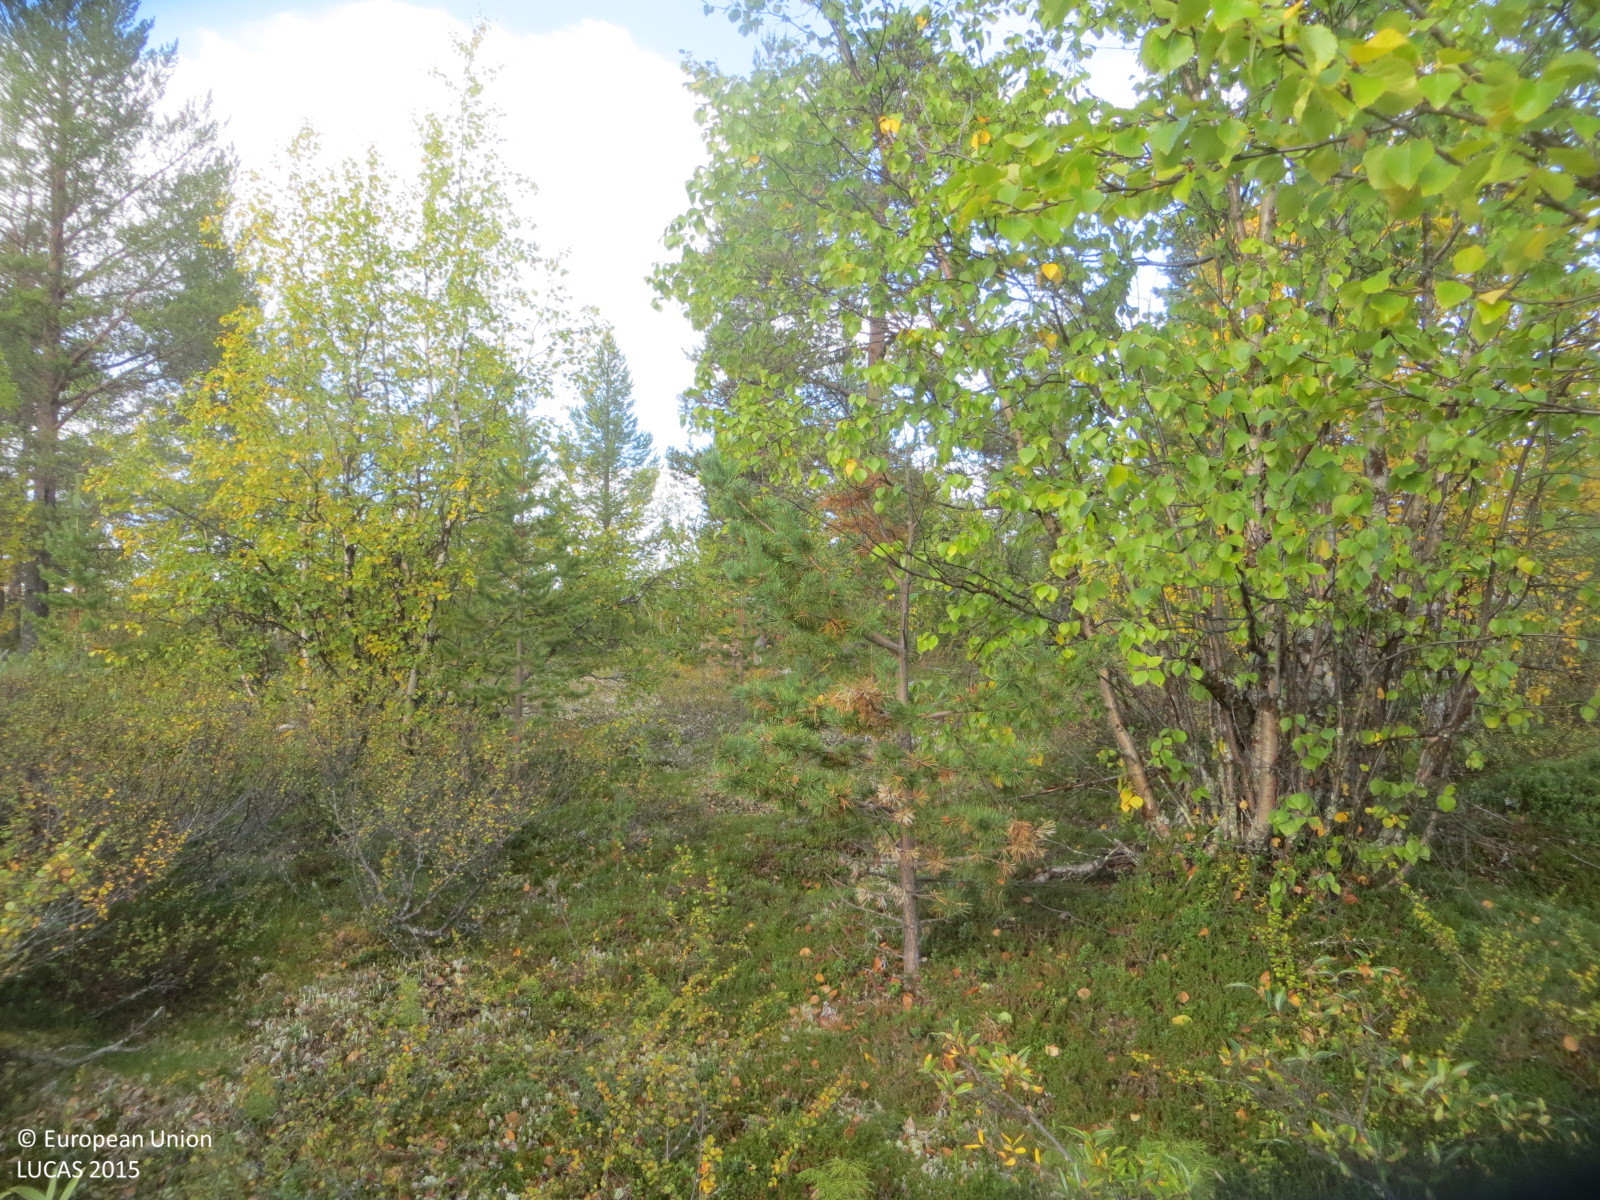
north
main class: Woodland
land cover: Pine dominated mixed woodland
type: boreal forest
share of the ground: 50 - 75 %
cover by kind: shrubs 50 %, broadleaved forest trees 35 %, coniferous forest trees 15 %
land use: Semi-natural and natural areas not in use
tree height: > 5 m
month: September
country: FI
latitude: 68.3999
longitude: 24.3028
